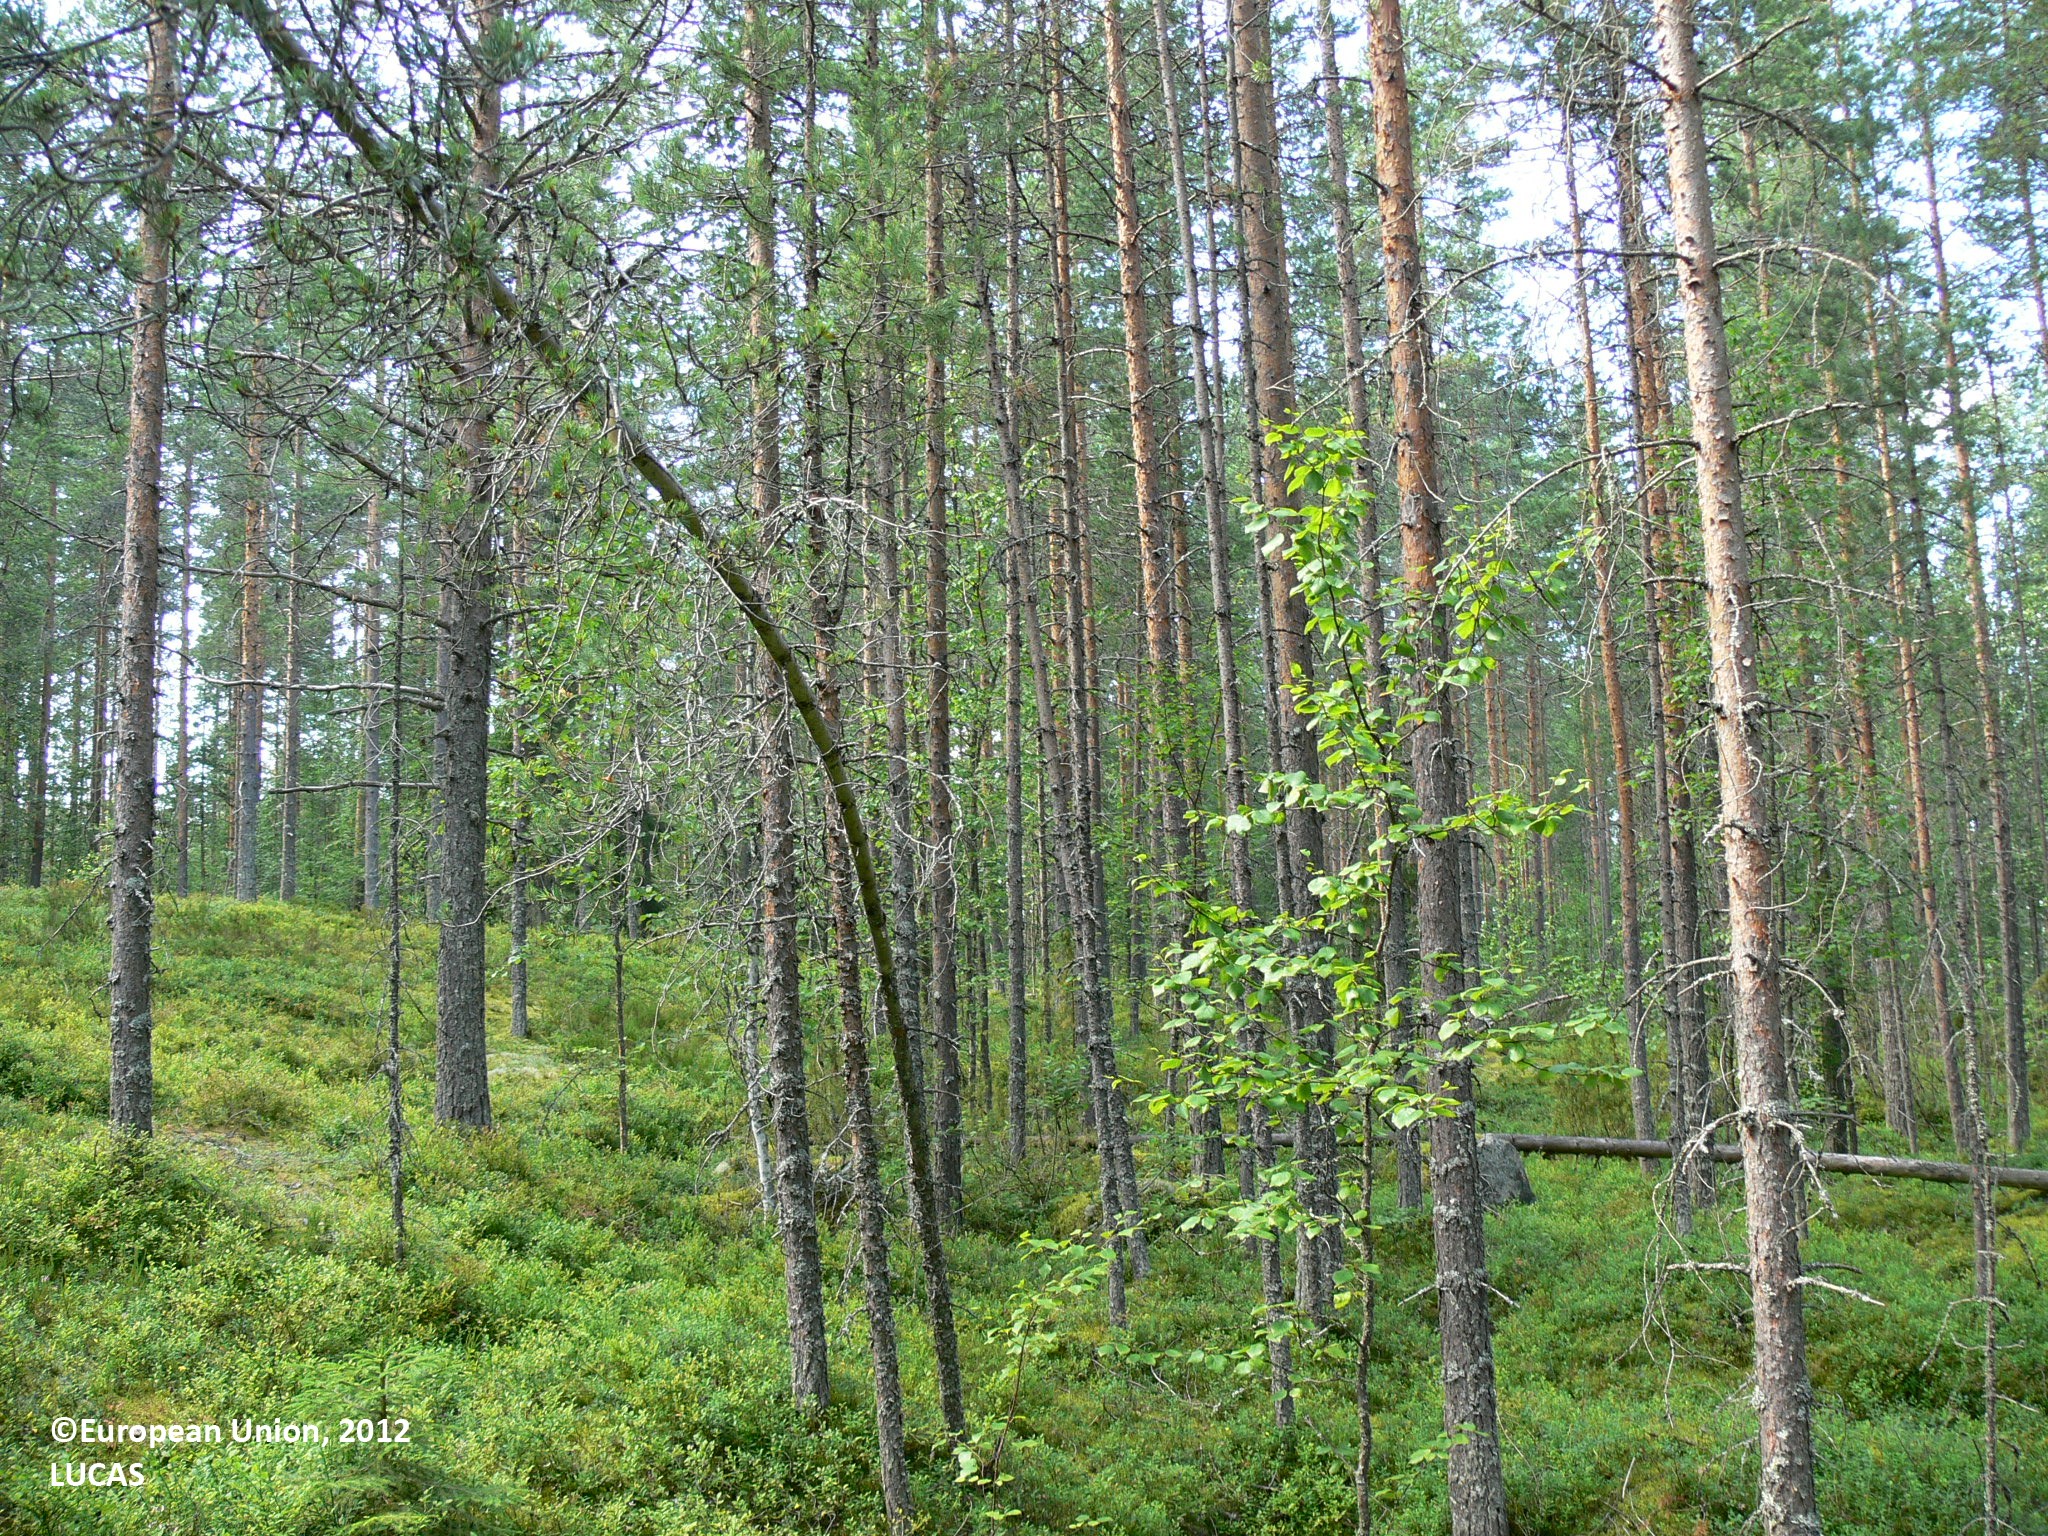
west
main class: Woodland
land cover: Pine dominated coniferous woodland
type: boreal forest
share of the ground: 50 - 75 %
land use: Forestry
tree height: > 5 m
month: July
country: FI
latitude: 63.2866
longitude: 29.3040
